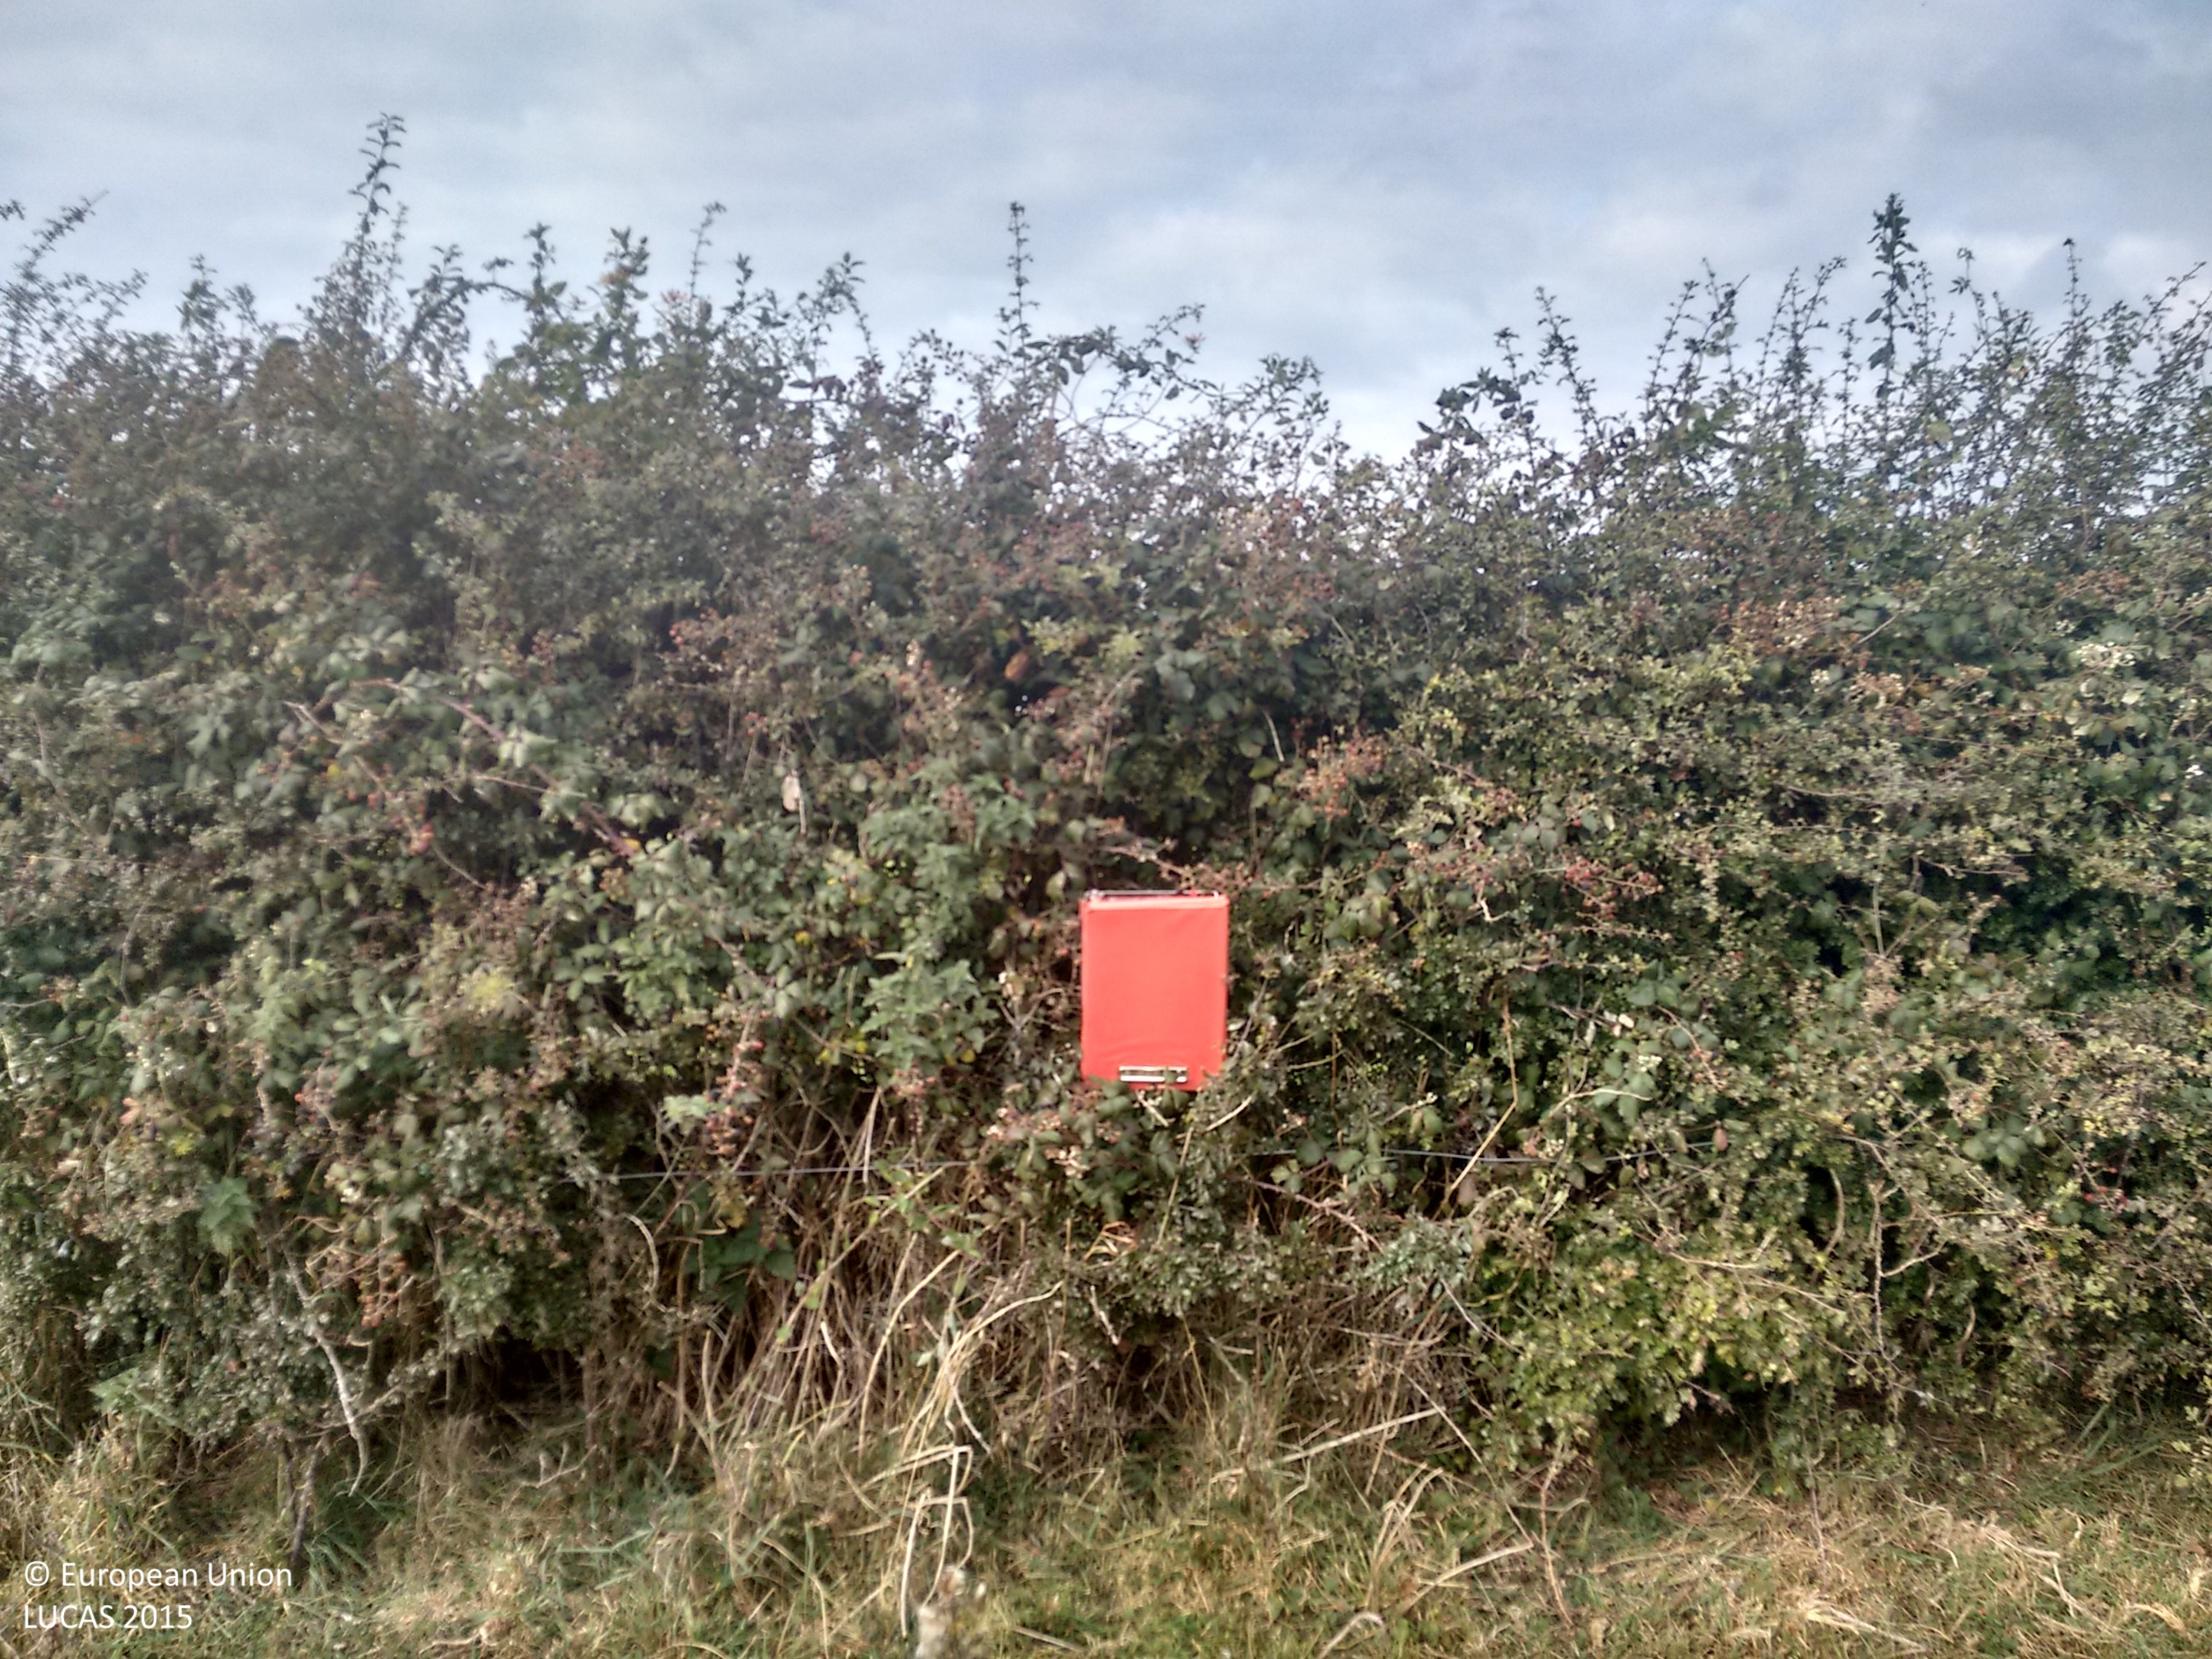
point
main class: Grassland
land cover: Grassland without tree/shrub cover
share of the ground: > 75 %
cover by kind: herbaceous plants 95 %, shrubs 5 %
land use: Agriculture (excluding fallow land and kitchen gardens)
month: October
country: IE
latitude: 52.8776
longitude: -7.5601
